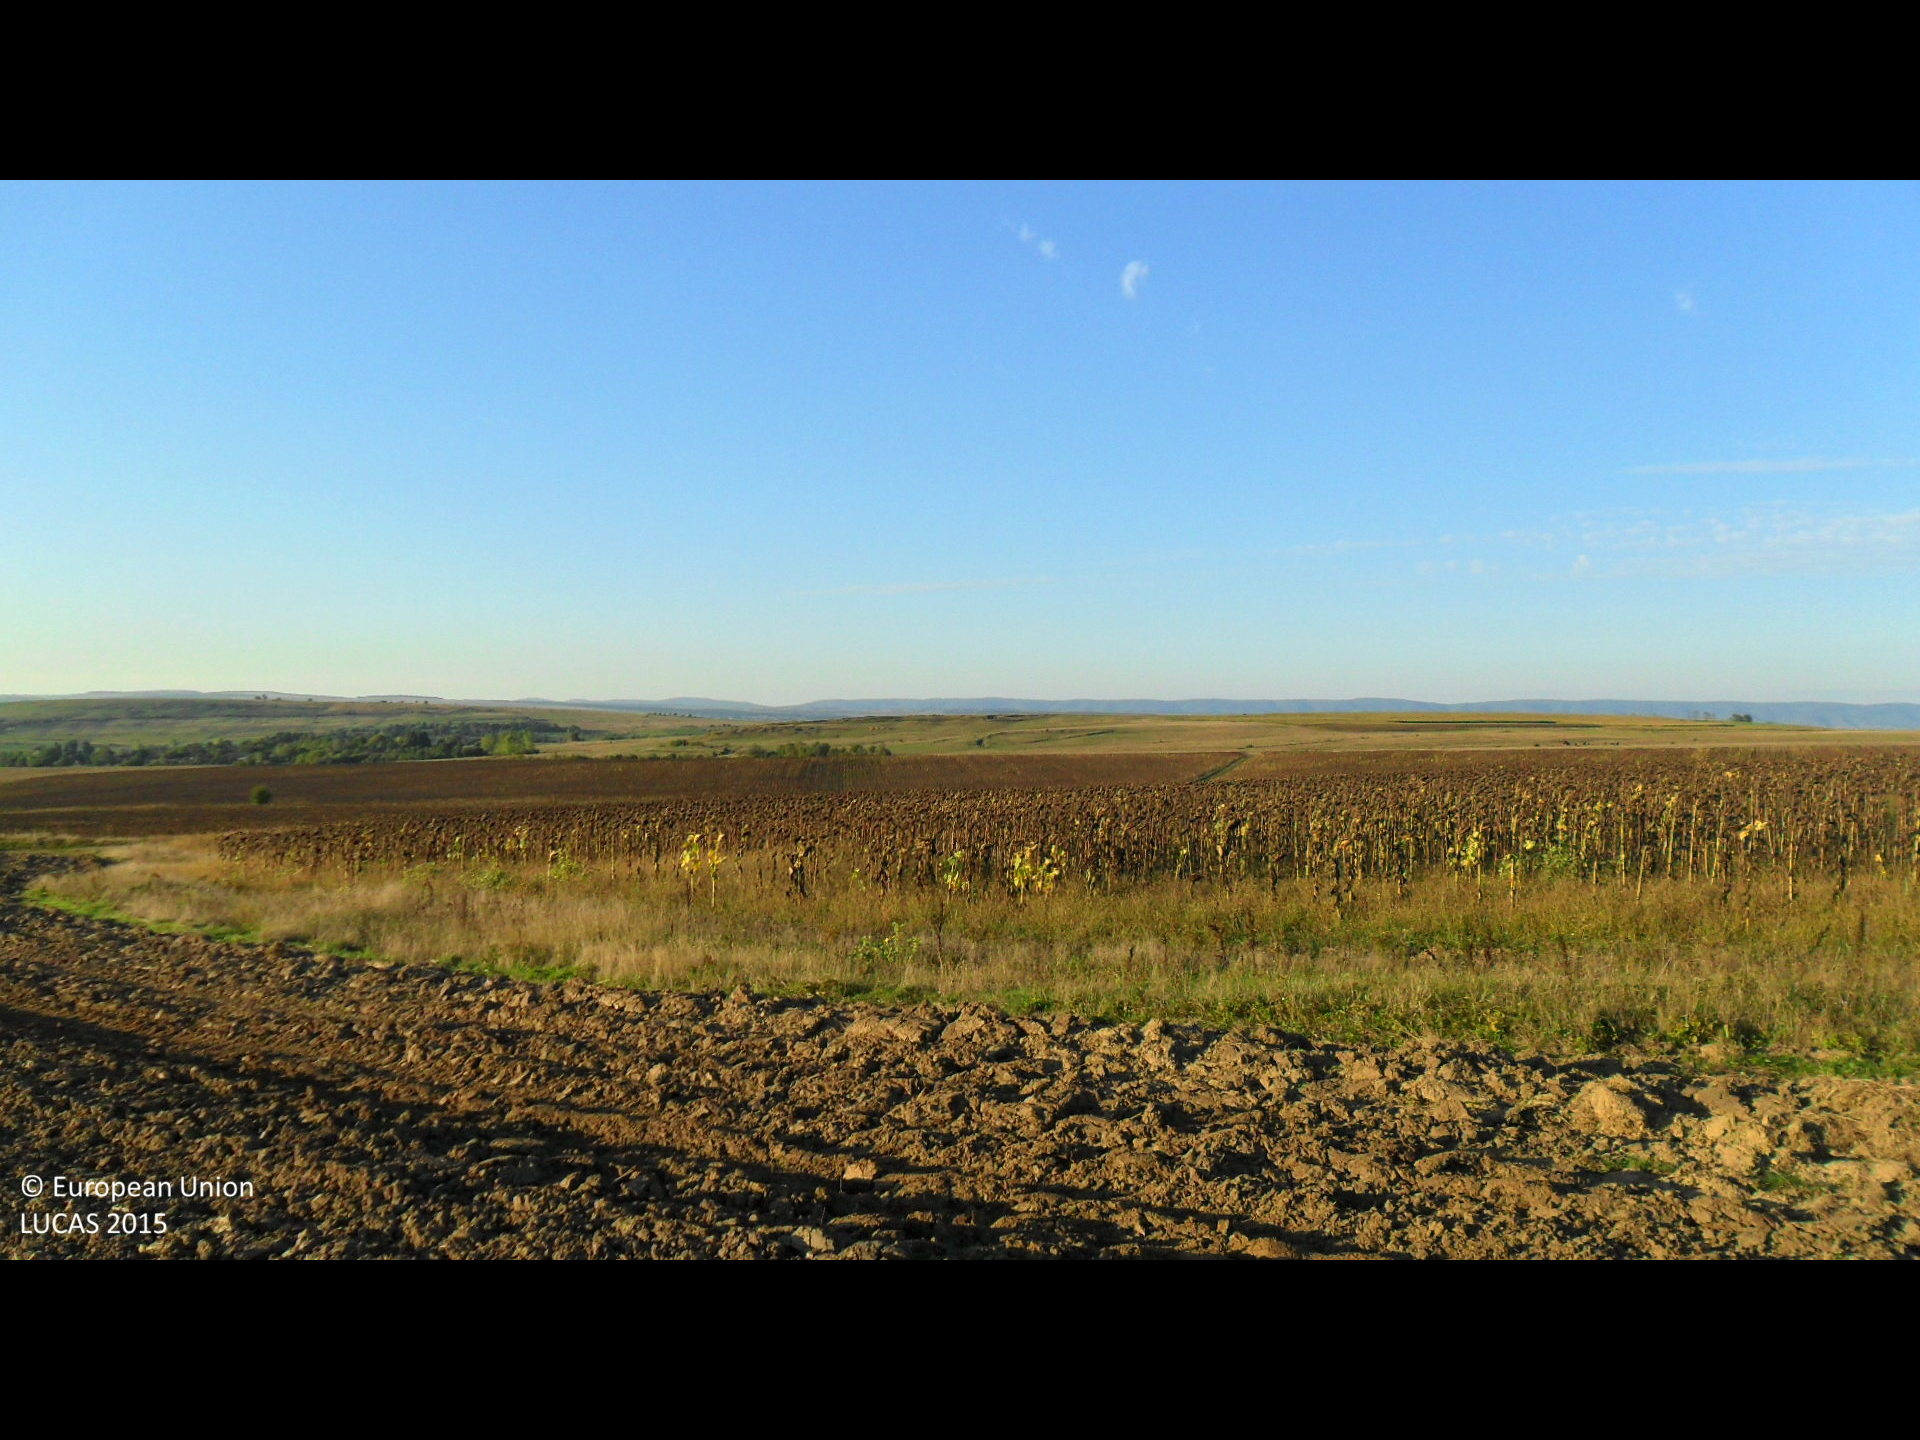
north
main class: Cropland
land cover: Common wheat
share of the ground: < 10 %
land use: Agriculture (excluding fallow land and kitchen gardens)
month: September
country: BG
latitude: 42.9885
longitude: 26.5713
